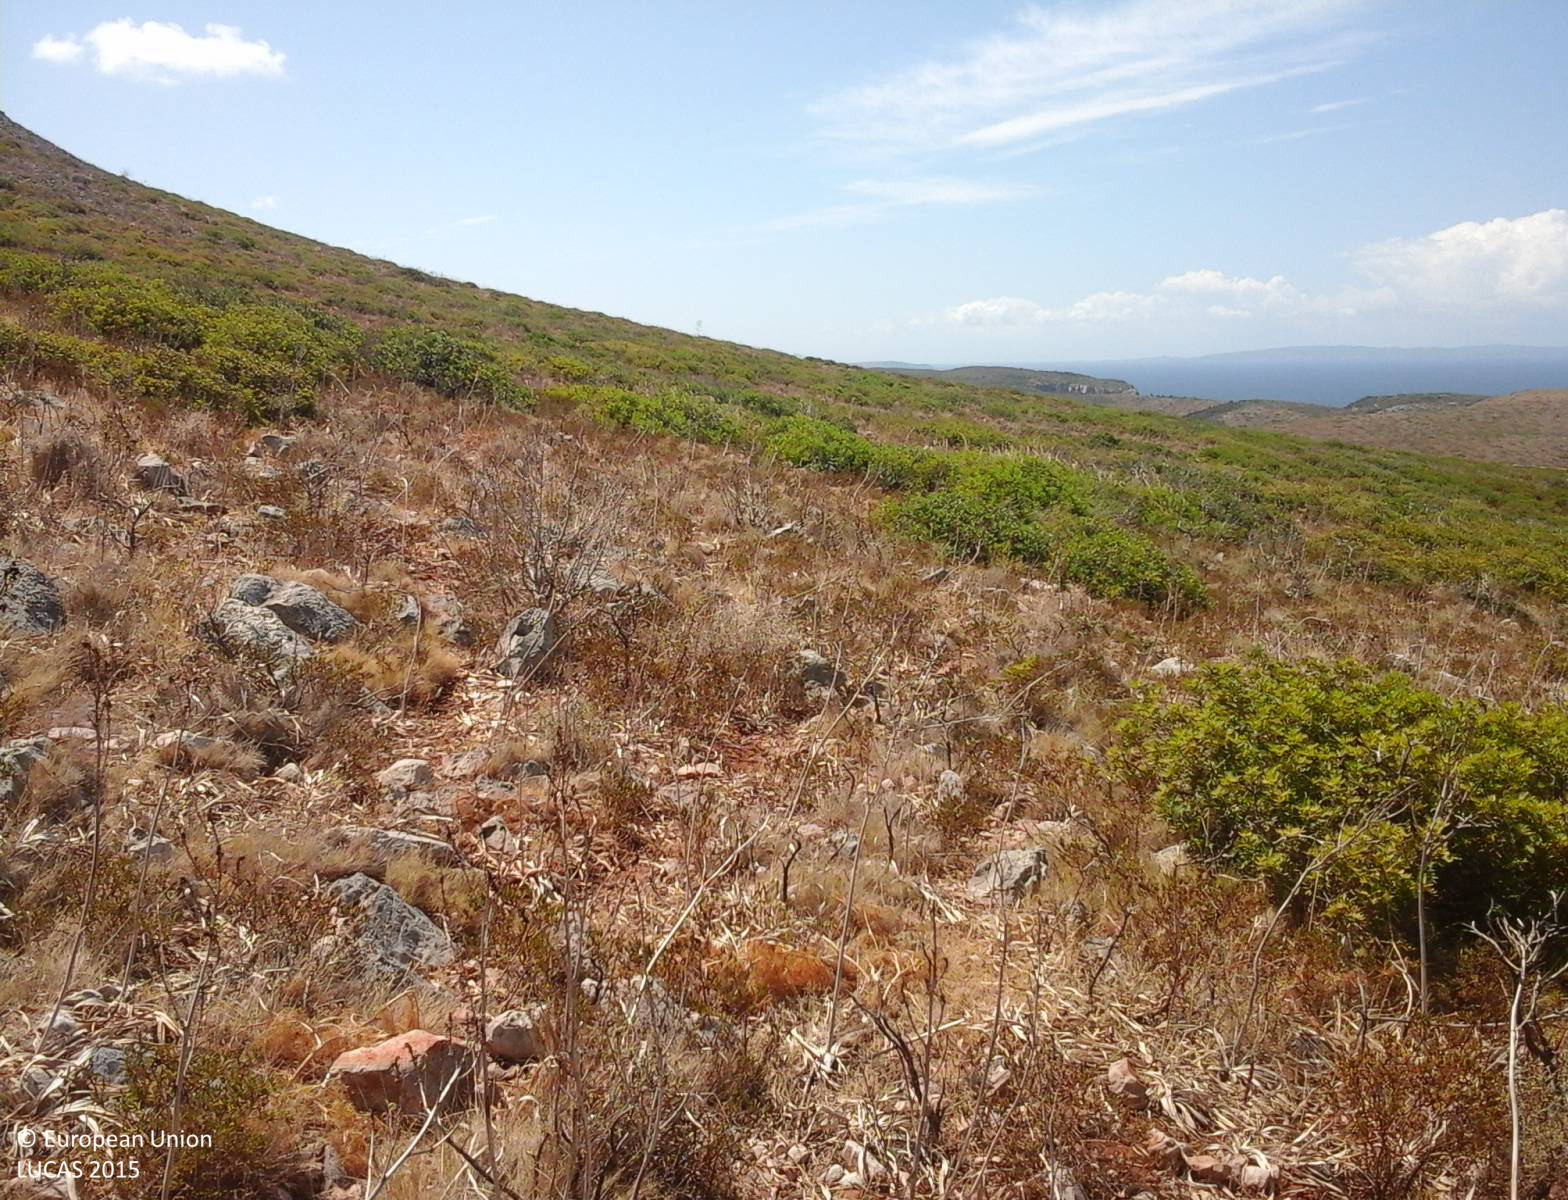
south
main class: Shrubland
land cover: Shrubland without tree cover
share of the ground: > 75 %
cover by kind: shrubs 100 %
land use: Forestry
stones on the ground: > 50 %
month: August
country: IT
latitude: 39.3848
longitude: 8.3959
